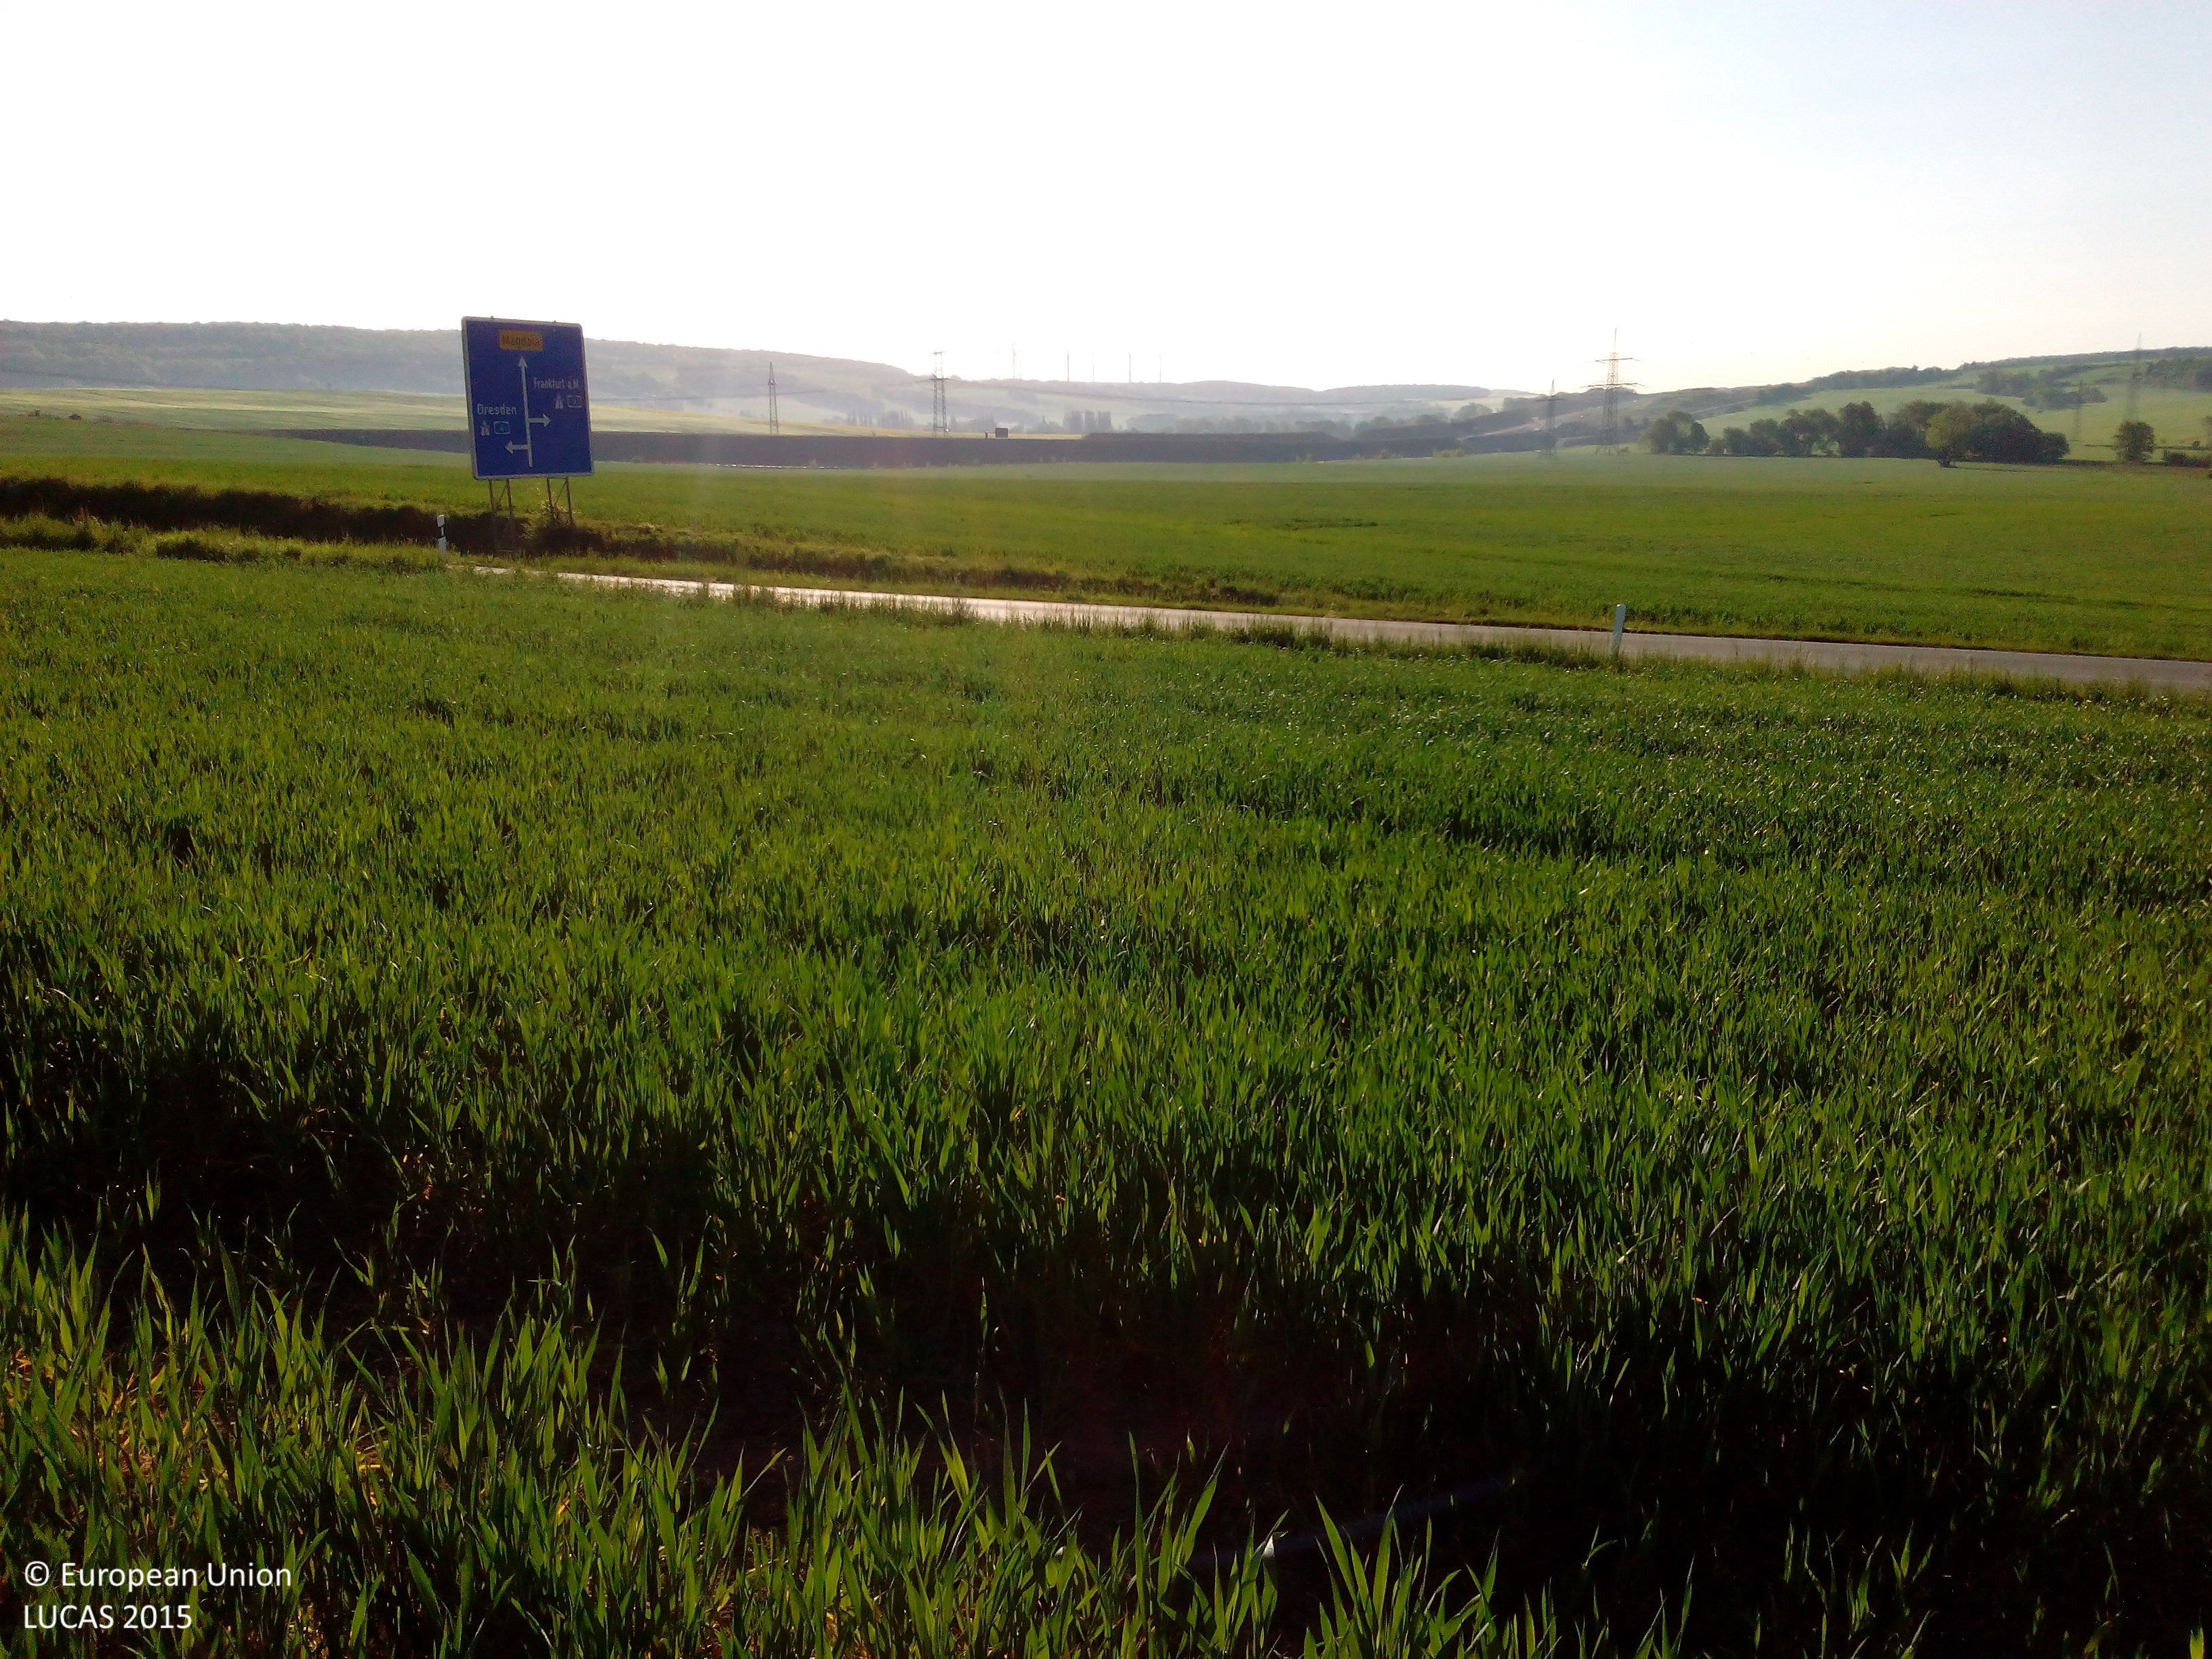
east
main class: Cropland
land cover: Triticale
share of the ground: > 75 %
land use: Agriculture (excluding fallow land and kitchen gardens)
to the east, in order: Triticale; Grass margins; Ditches and canals; Grass margins; Paved roads, cycling and walking lanes; Grass margins; Ditches and canals; Grass margins; Common wheat
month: May
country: DE
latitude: 50.8945
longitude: 11.4356
